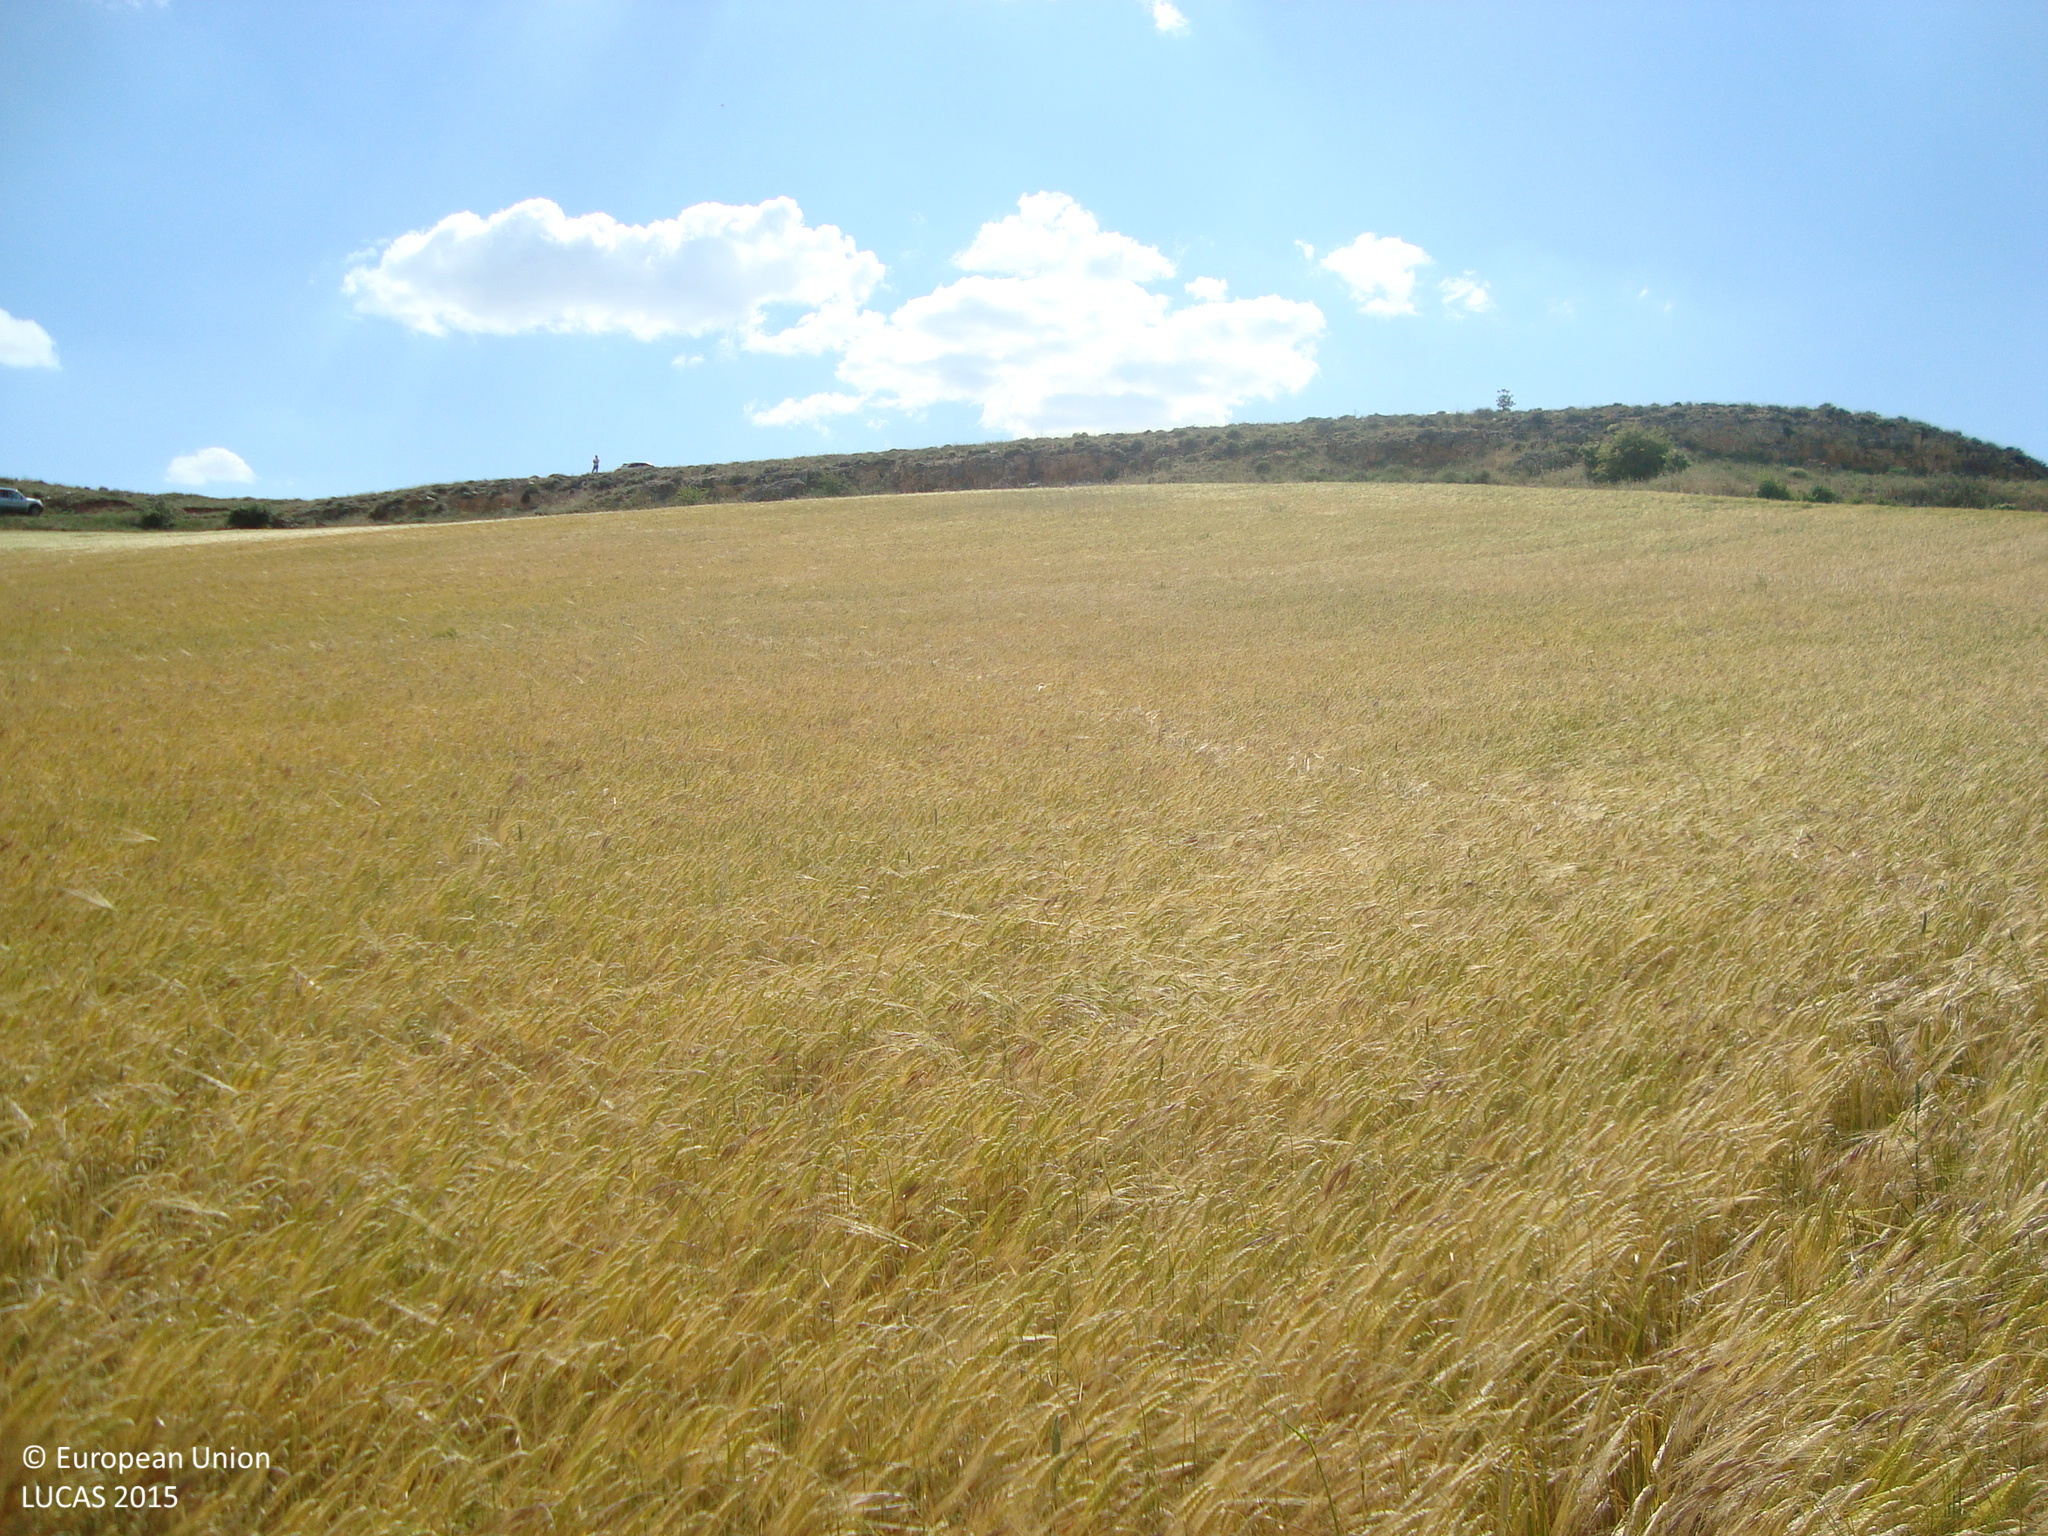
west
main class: Cropland
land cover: Barley
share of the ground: > 75 %
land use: Agriculture (excluding fallow land and kitchen gardens)
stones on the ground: < 10 %
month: May
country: ES
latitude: 41.5838
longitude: -4.0066
